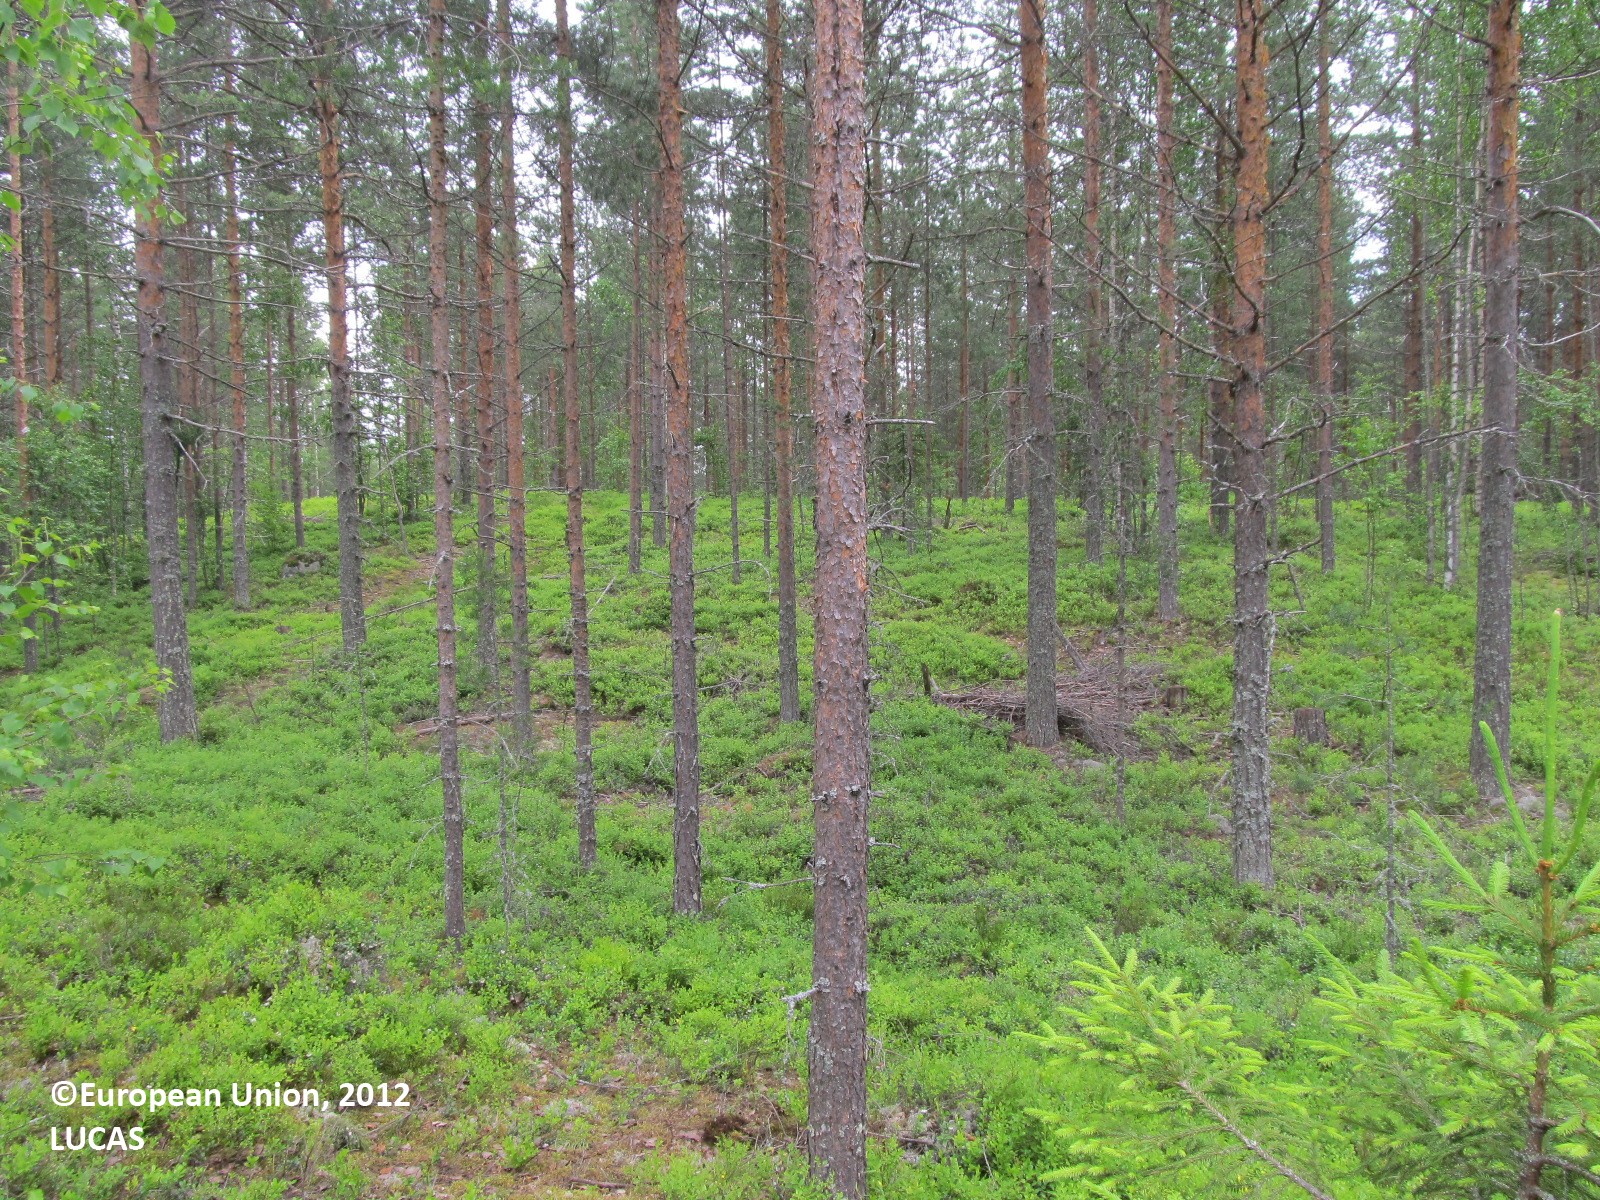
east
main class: Woodland
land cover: Pine dominated coniferous woodland
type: boreal forest
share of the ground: 50 - 75 %
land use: Forestry
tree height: > 5 m
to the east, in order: Pine dominated coniferous woodland; Paved roads, cycling and walking lanes; Ditches and canals; Pine dominated coniferous woodland
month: June
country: FI
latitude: 62.8403
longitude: 28.8450
